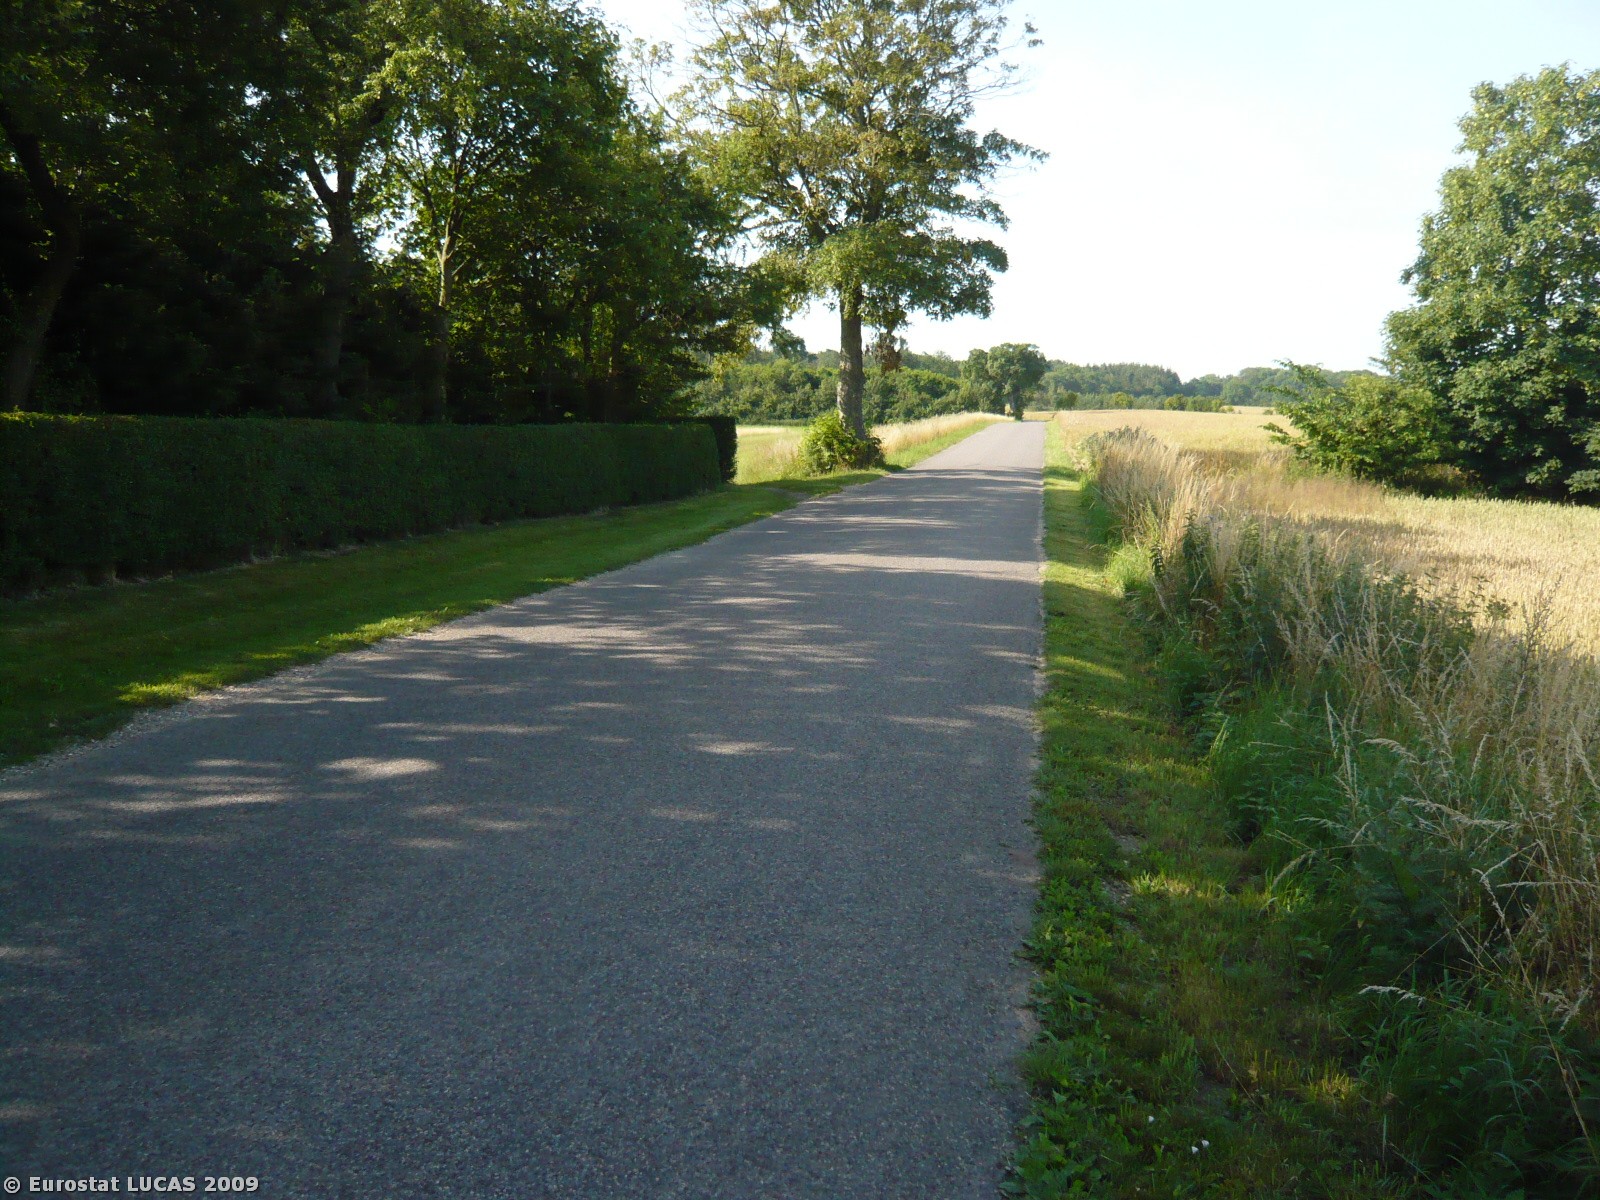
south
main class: Cropland
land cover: Common wheat
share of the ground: > 75 %
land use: Agriculture (excluding fallow land and kitchen gardens)
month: July
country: DK
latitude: 55.6008
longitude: 11.7284
